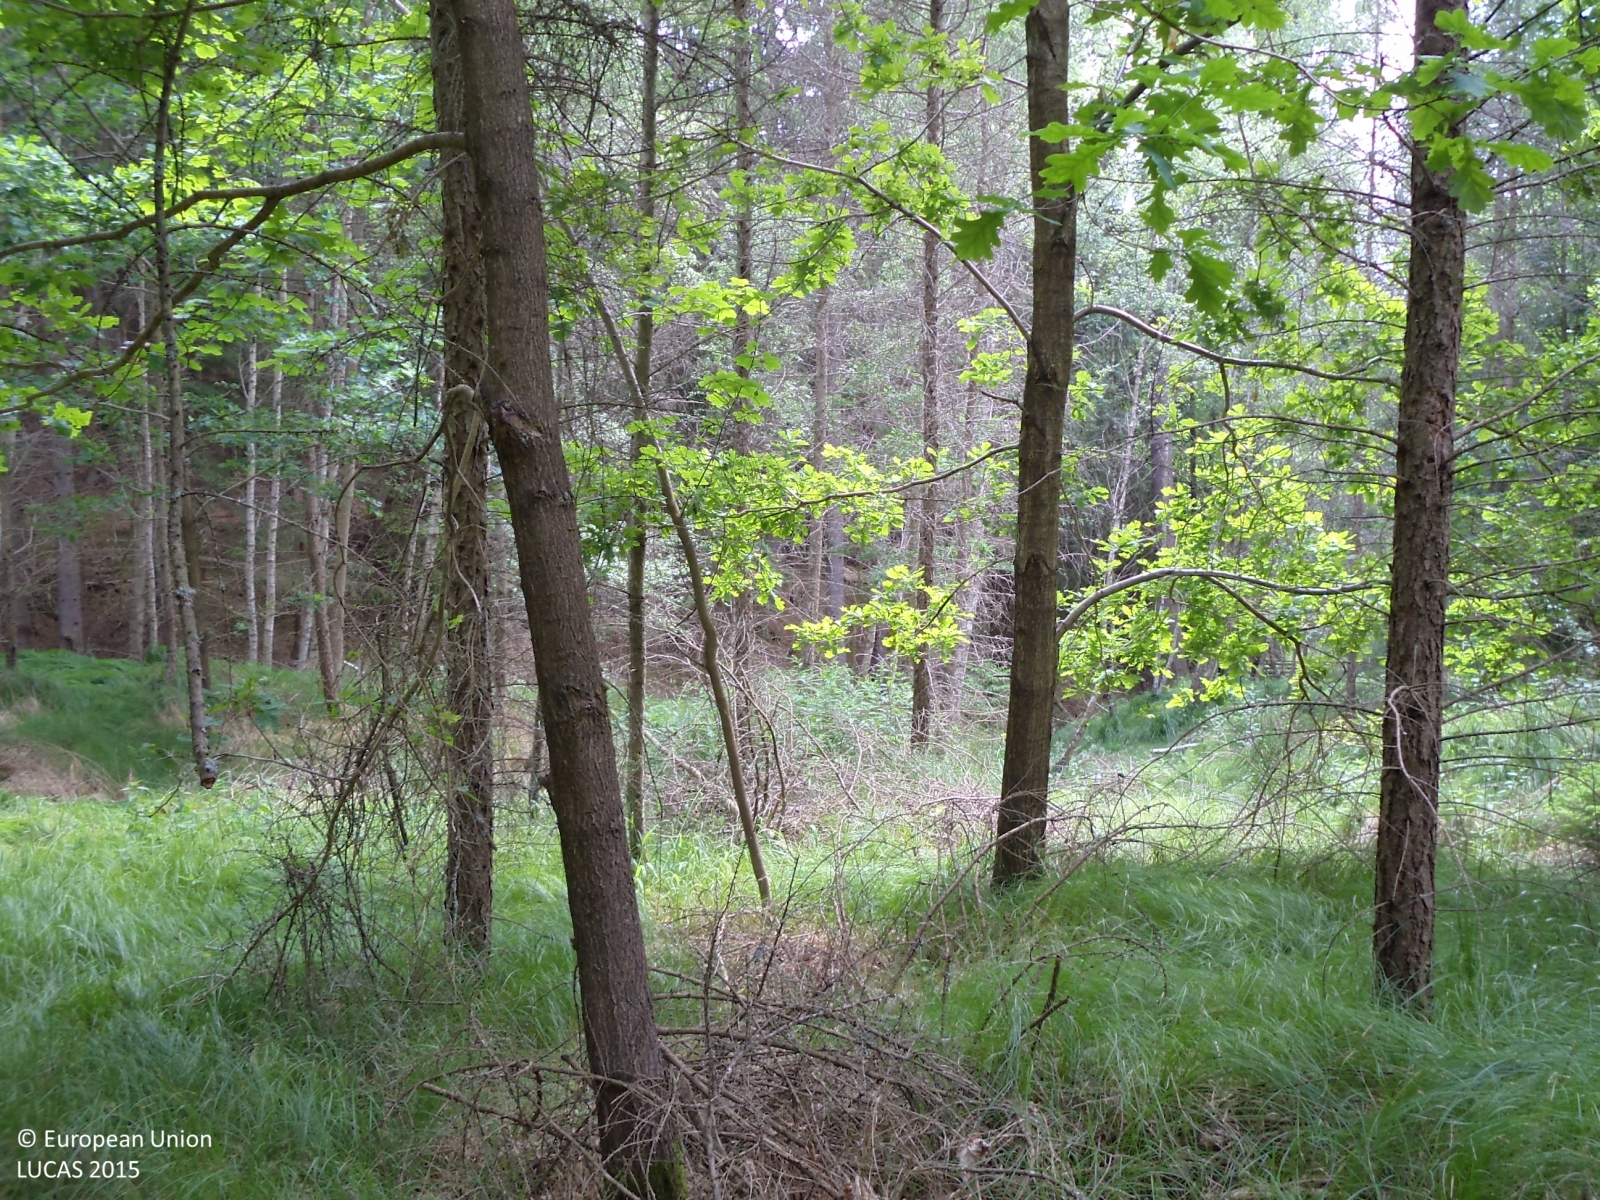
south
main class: Woodland
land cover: Pine dominated mixed woodland
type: hemiboreal forest and nemoral coniferous forest and mixed broadleaved-coniferous forest
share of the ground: > 75 %
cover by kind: coniferous forest trees 50 %, broadleaved forest trees 40 %, herbaceous plants 10 %
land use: Forestry
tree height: > 5 m
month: June
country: CZ
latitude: 49.1436
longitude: 14.4290
